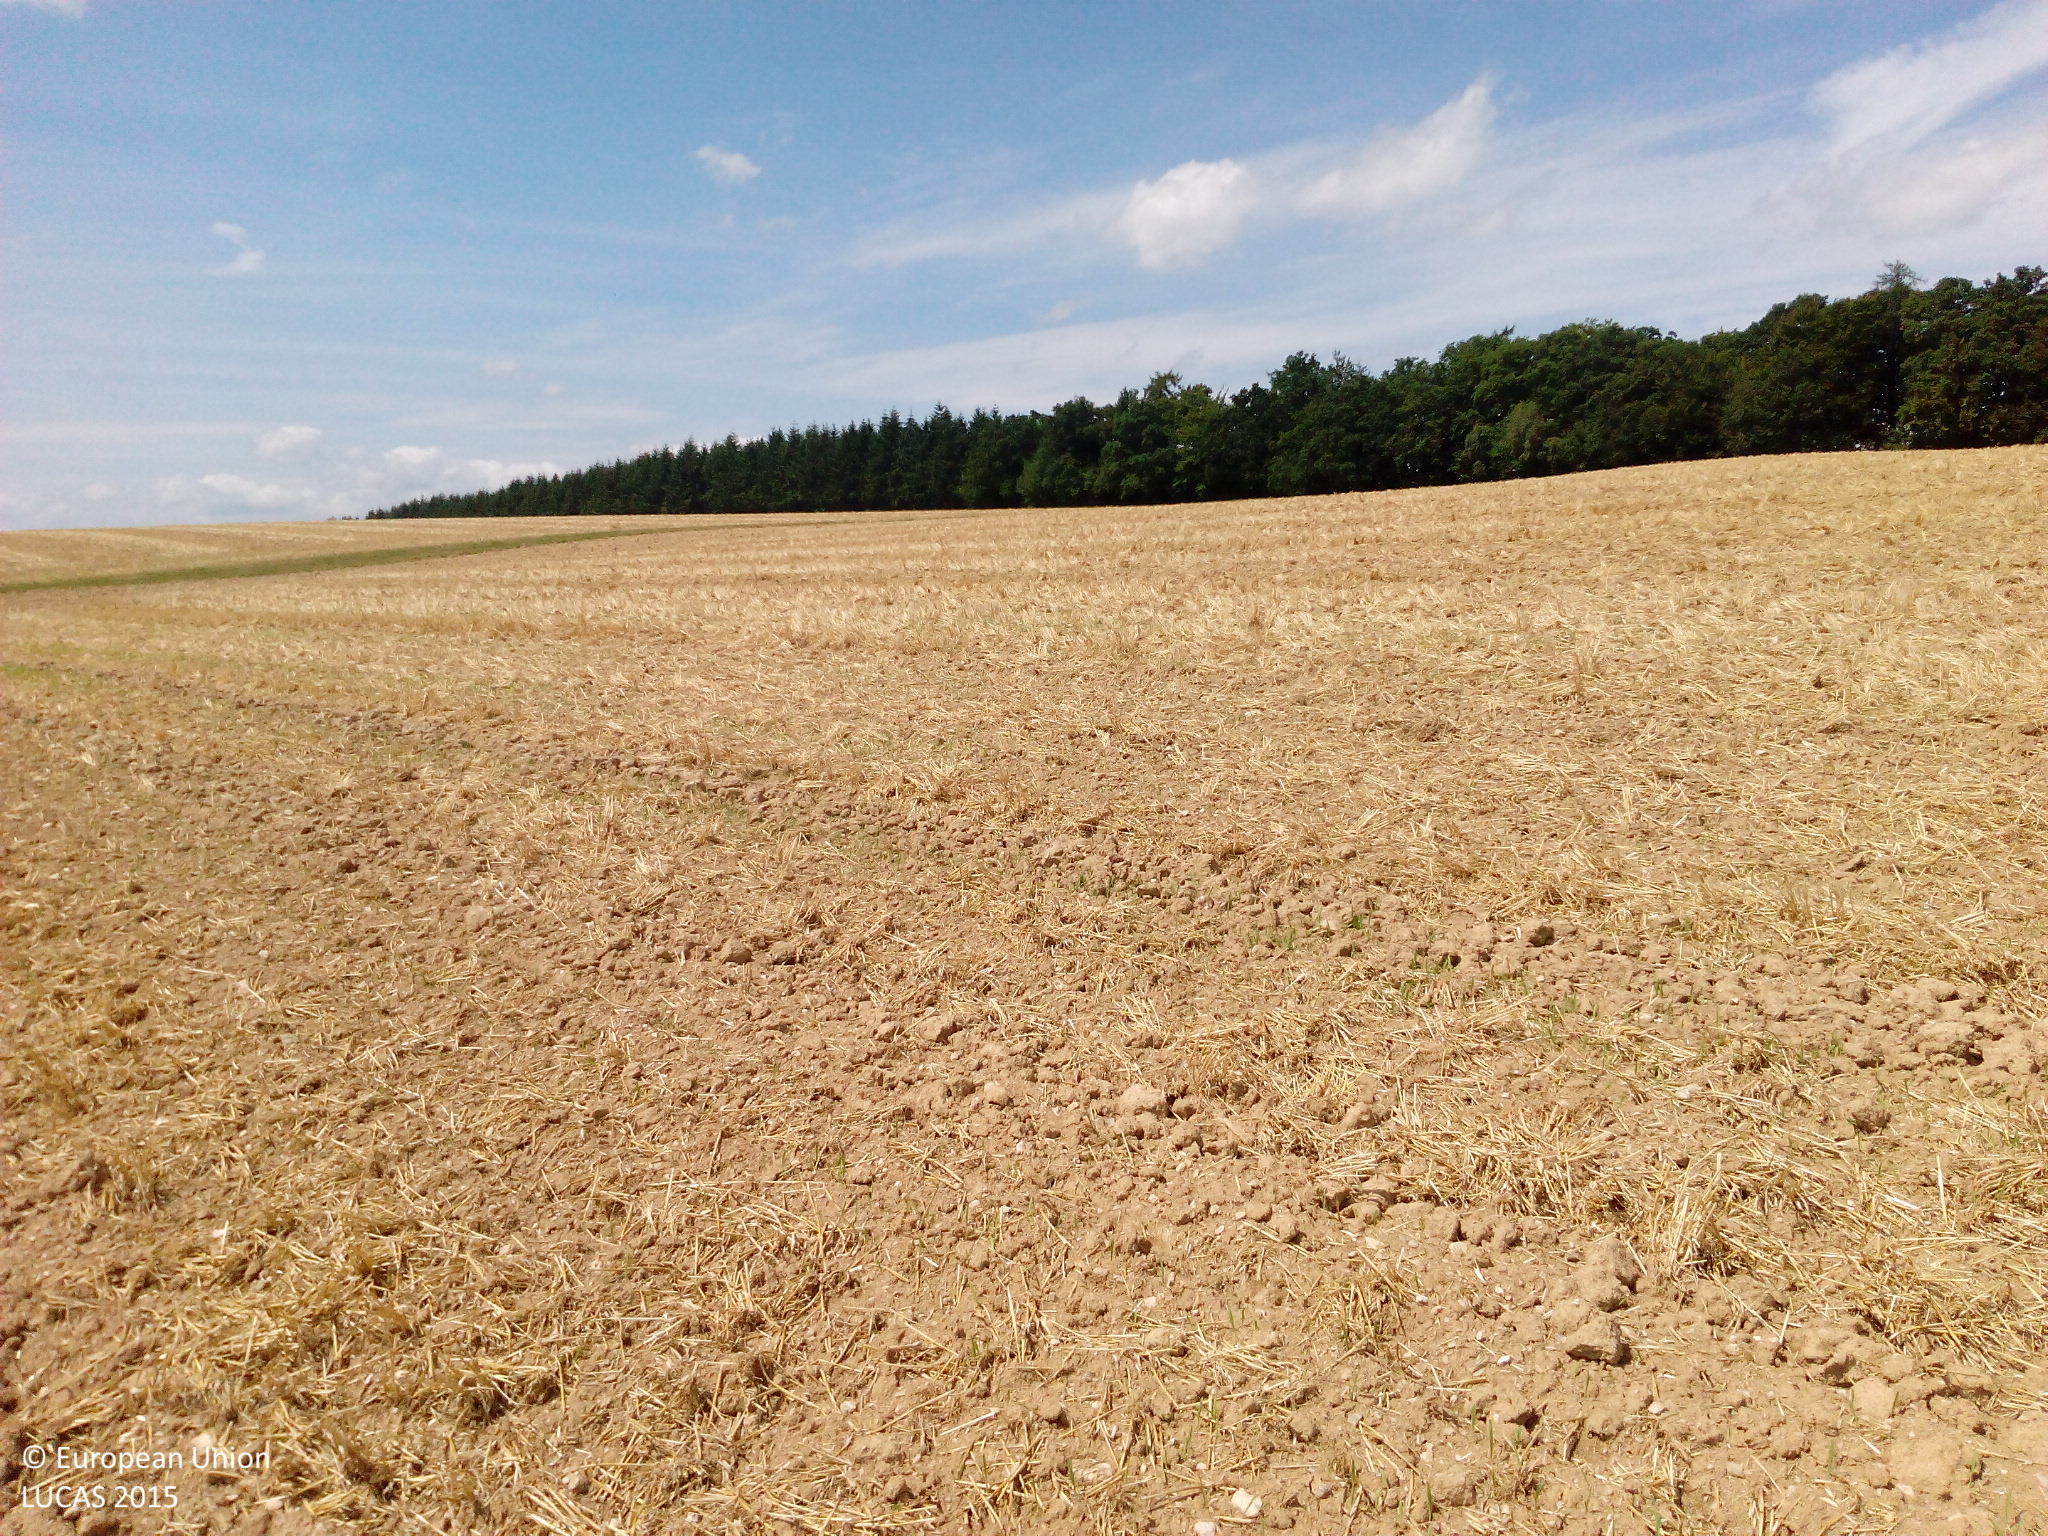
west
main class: Cropland
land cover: Barley
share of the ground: < 10 %
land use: Agriculture (excluding fallow land and kitchen gardens)
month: July
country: DE
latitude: 49.9417
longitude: 7.5340
